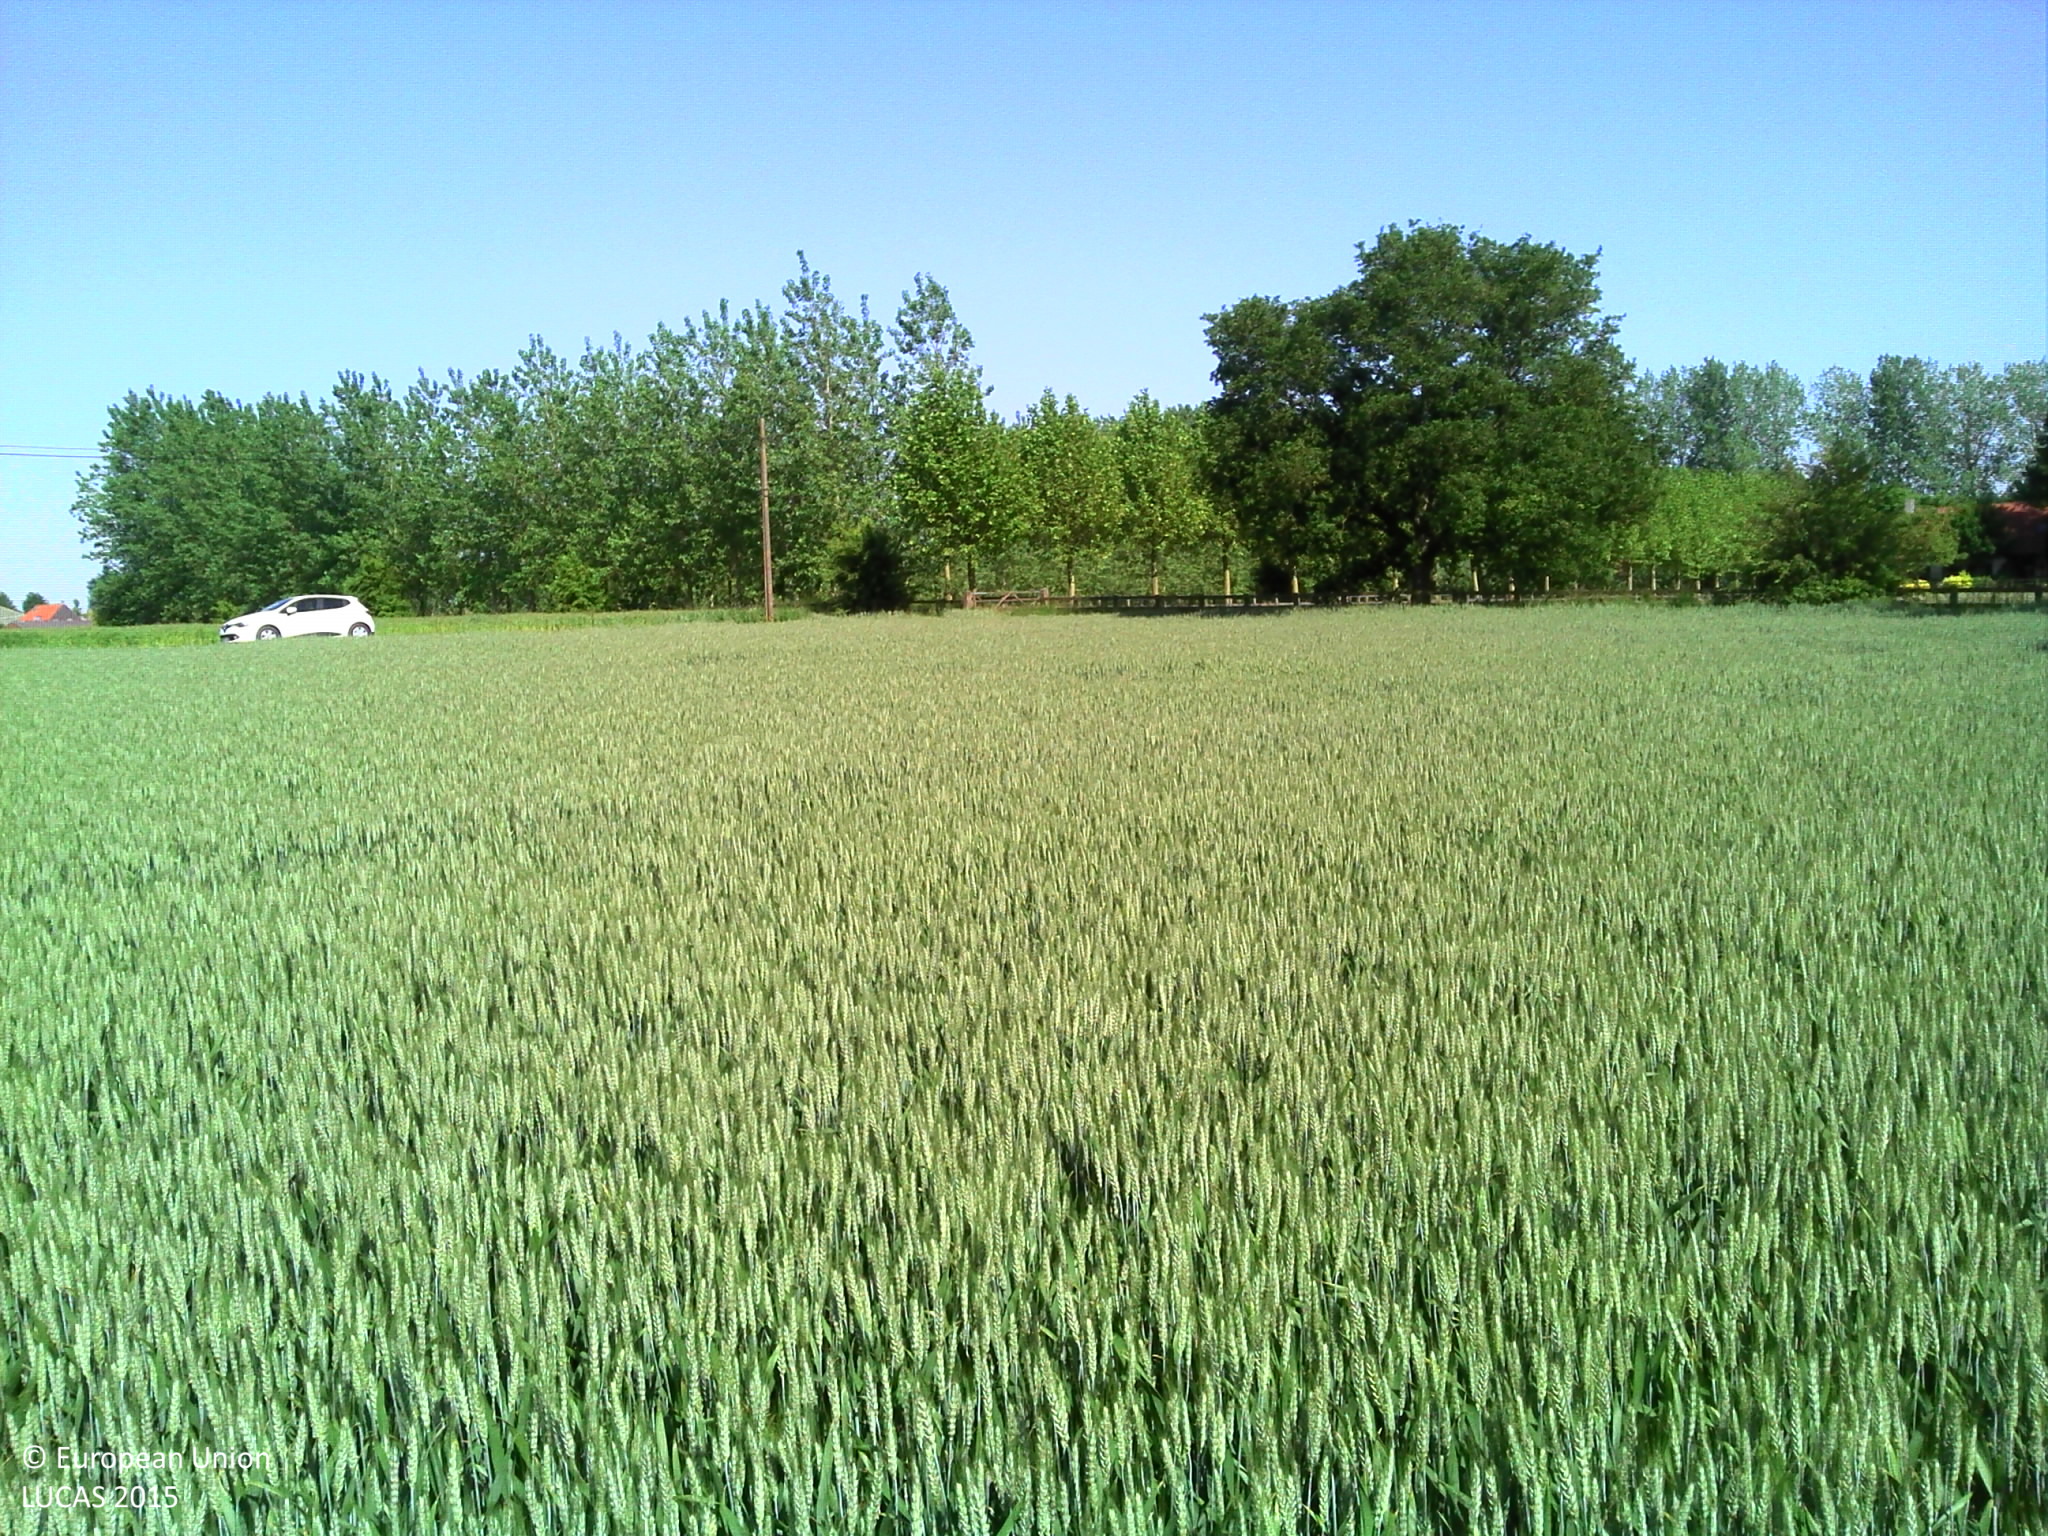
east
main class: Cropland
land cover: Common wheat
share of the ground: > 75 %
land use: Agriculture (excluding fallow land and kitchen gardens)
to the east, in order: Common wheat; Grass margins; Paved roads, cycling and walking lanes; Grass margins; Electric lines; Common wheat; Grass margins; Lines of trees; Fences; Grassland without tree/shrub cover; Lines of trees; Fences; Grassland without tree/shrub cover; Lines of trees; Fences; Common wheat
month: June
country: BE
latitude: 50.8578
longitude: 3.0718
